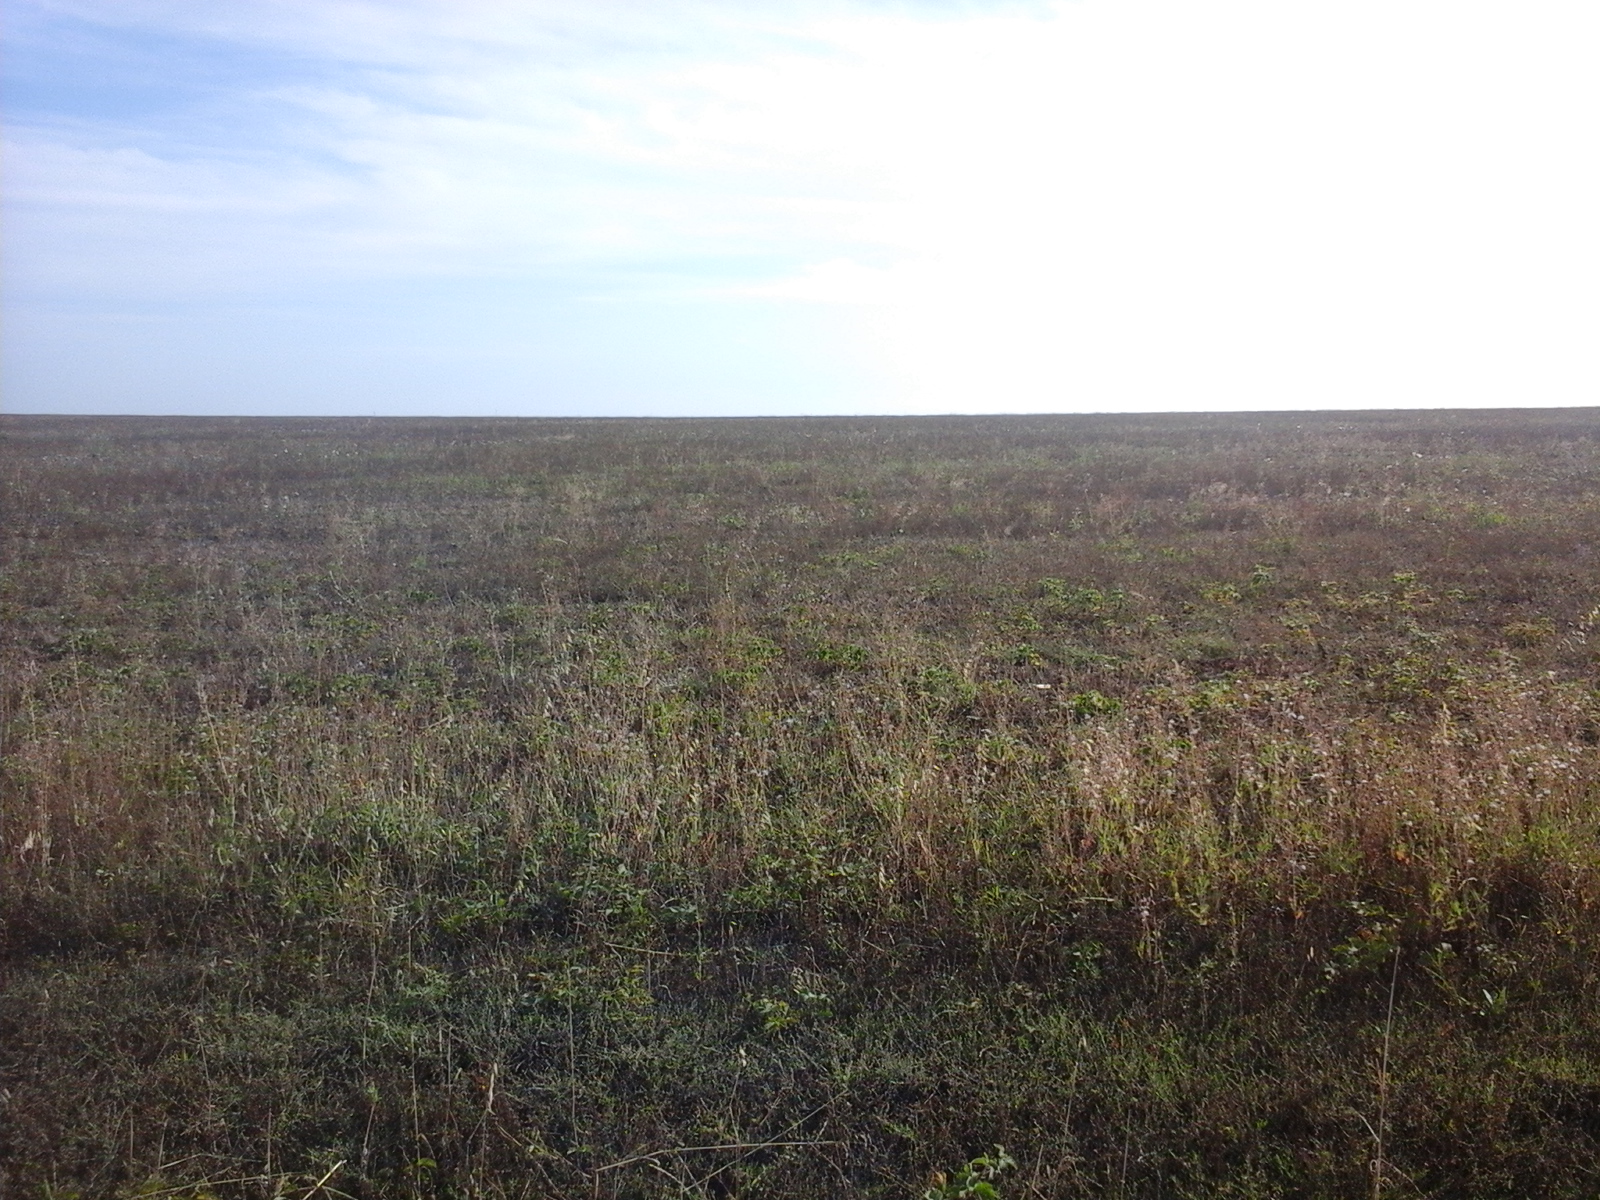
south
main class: Cropland
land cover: Sunflower
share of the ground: > 75 %
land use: Agriculture (excluding fallow land and kitchen gardens)
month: August
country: RO
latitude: 46.0370
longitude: 21.3393
